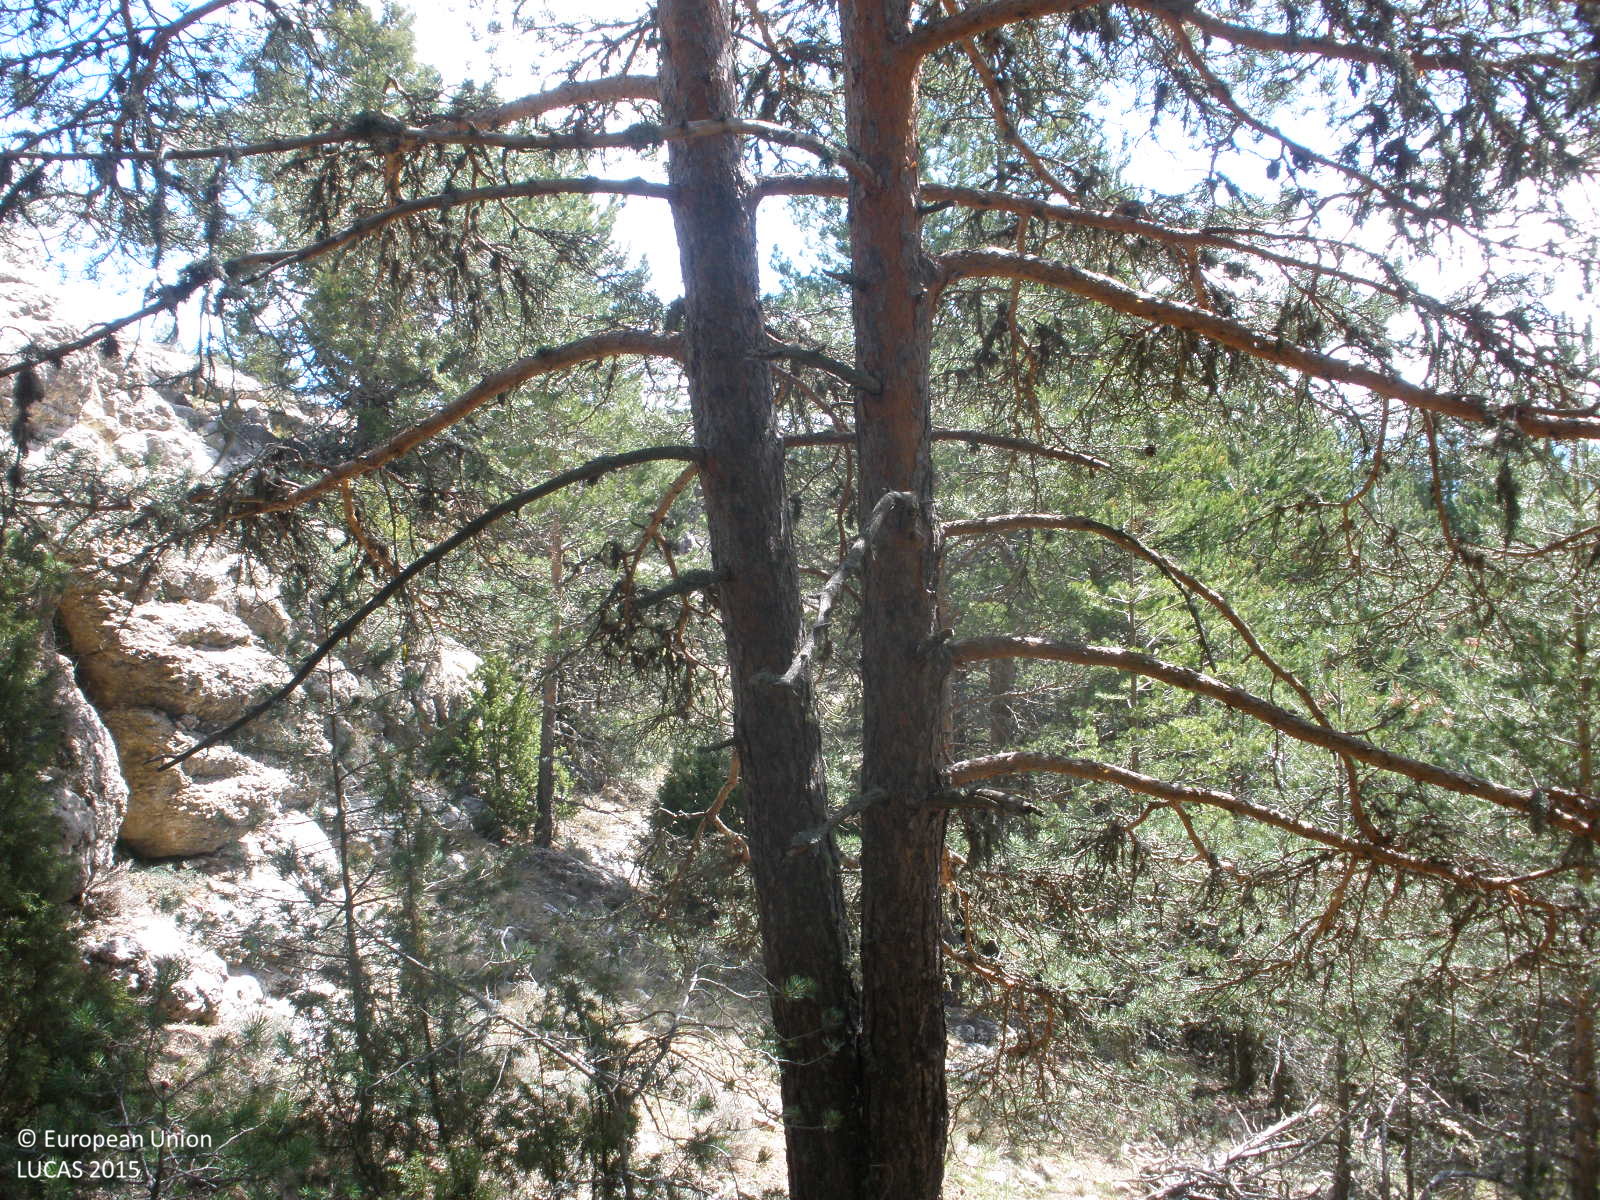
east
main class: Woodland
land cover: Pine dominated coniferous woodland
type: coniferous forest of the mediterranean region
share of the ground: > 75 %
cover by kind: coniferous forest trees 80 %, herbaceous plants 10 %, consolidated bare surface 10 %
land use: Semi-natural and natural areas not in use
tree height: > 5 m
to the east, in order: Pine dominated coniferous woodland; Artificial constructions in urban areas; Pine dominated coniferous woodland
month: April
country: ES
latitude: 40.3667
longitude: -0.7605
